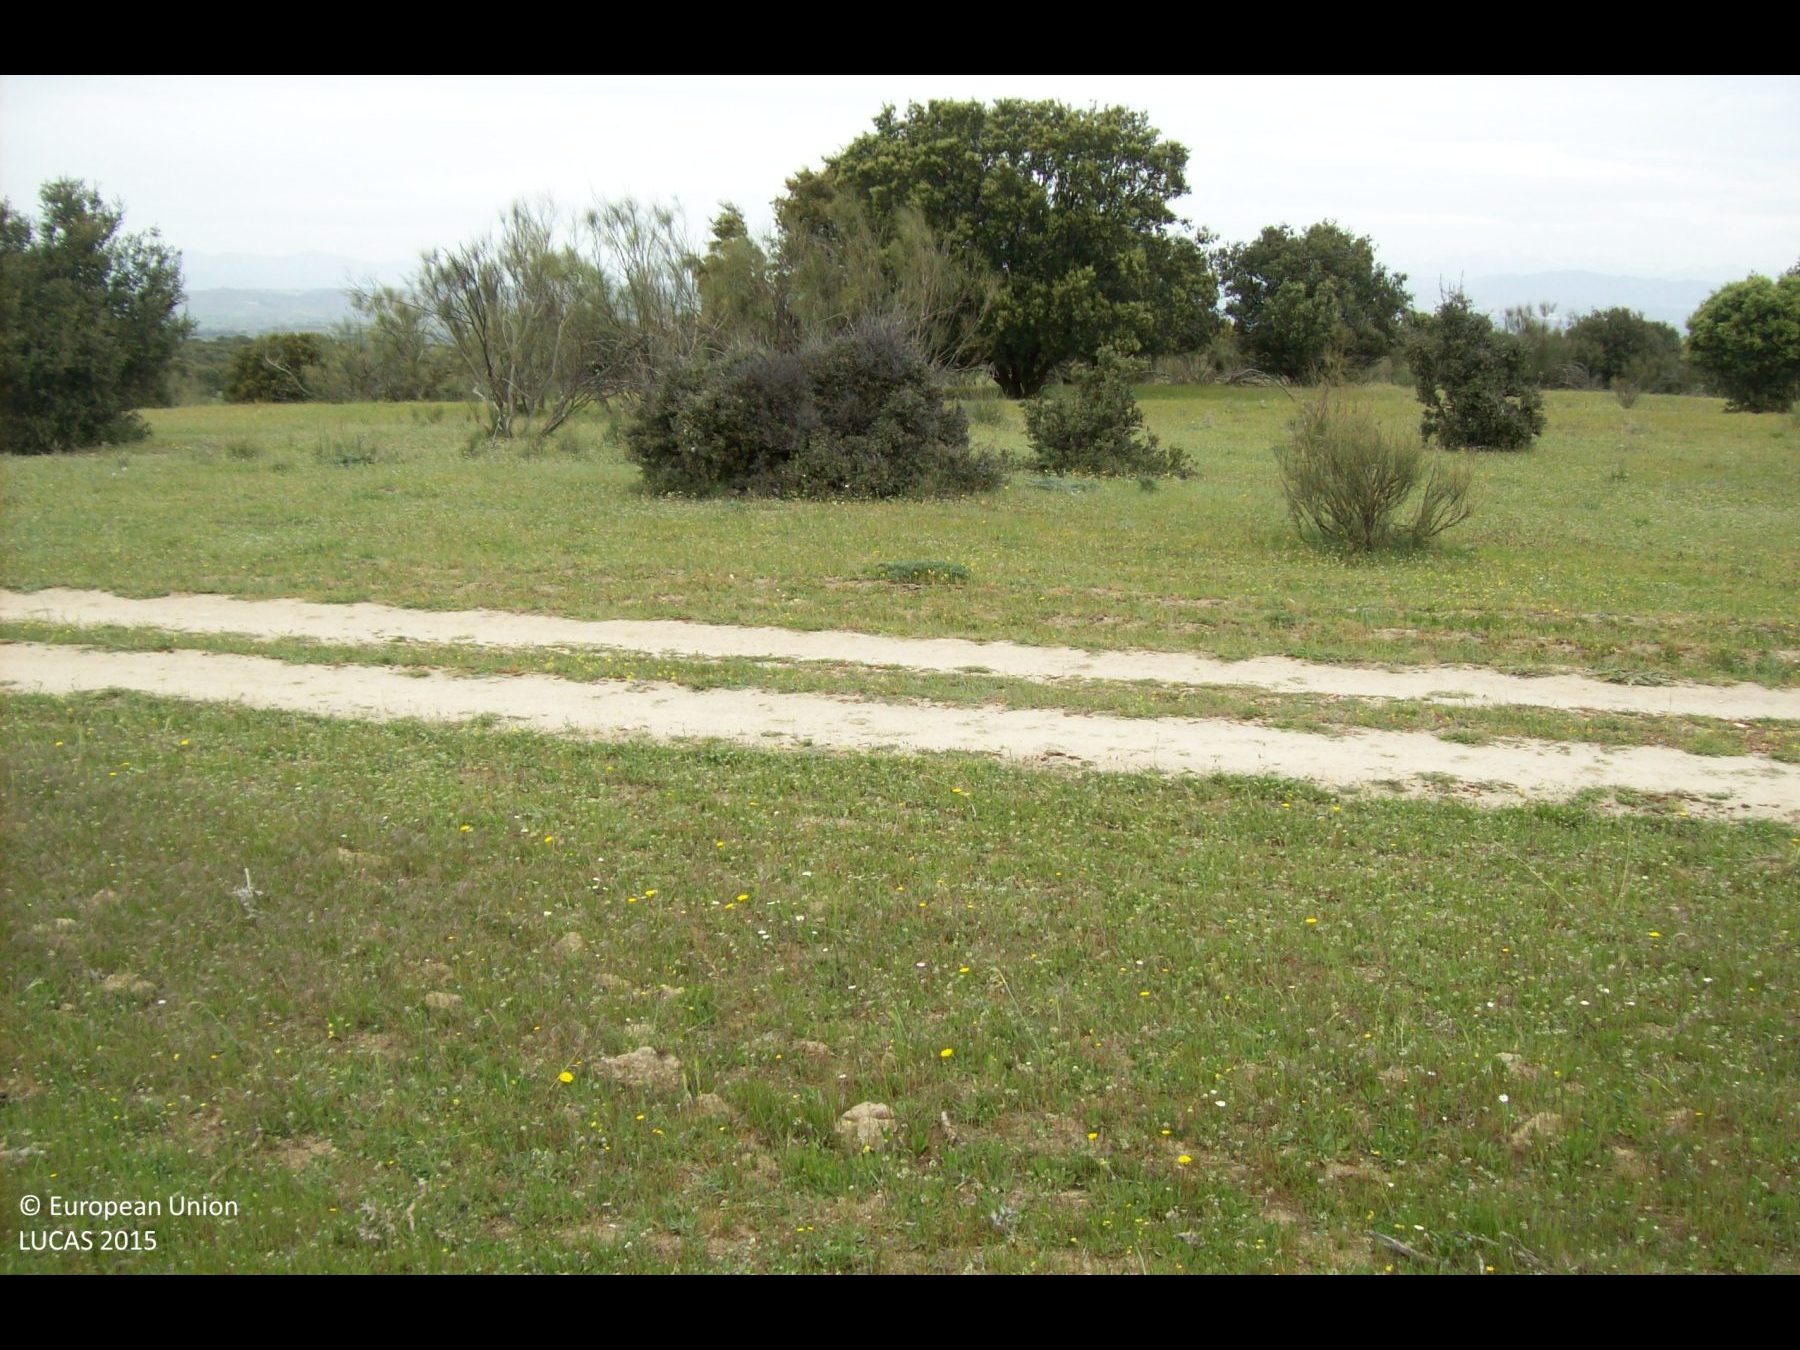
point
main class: Grassland
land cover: Grassland with sparse tree/shrub cover
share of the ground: > 75 %
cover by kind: herbaceous plants 75 %, broadleaved forest trees 5 %, shrubs 5 %
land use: Semi-natural and natural areas not in use
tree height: < 5 m
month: April
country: ES
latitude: 40.4429
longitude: -3.9174
